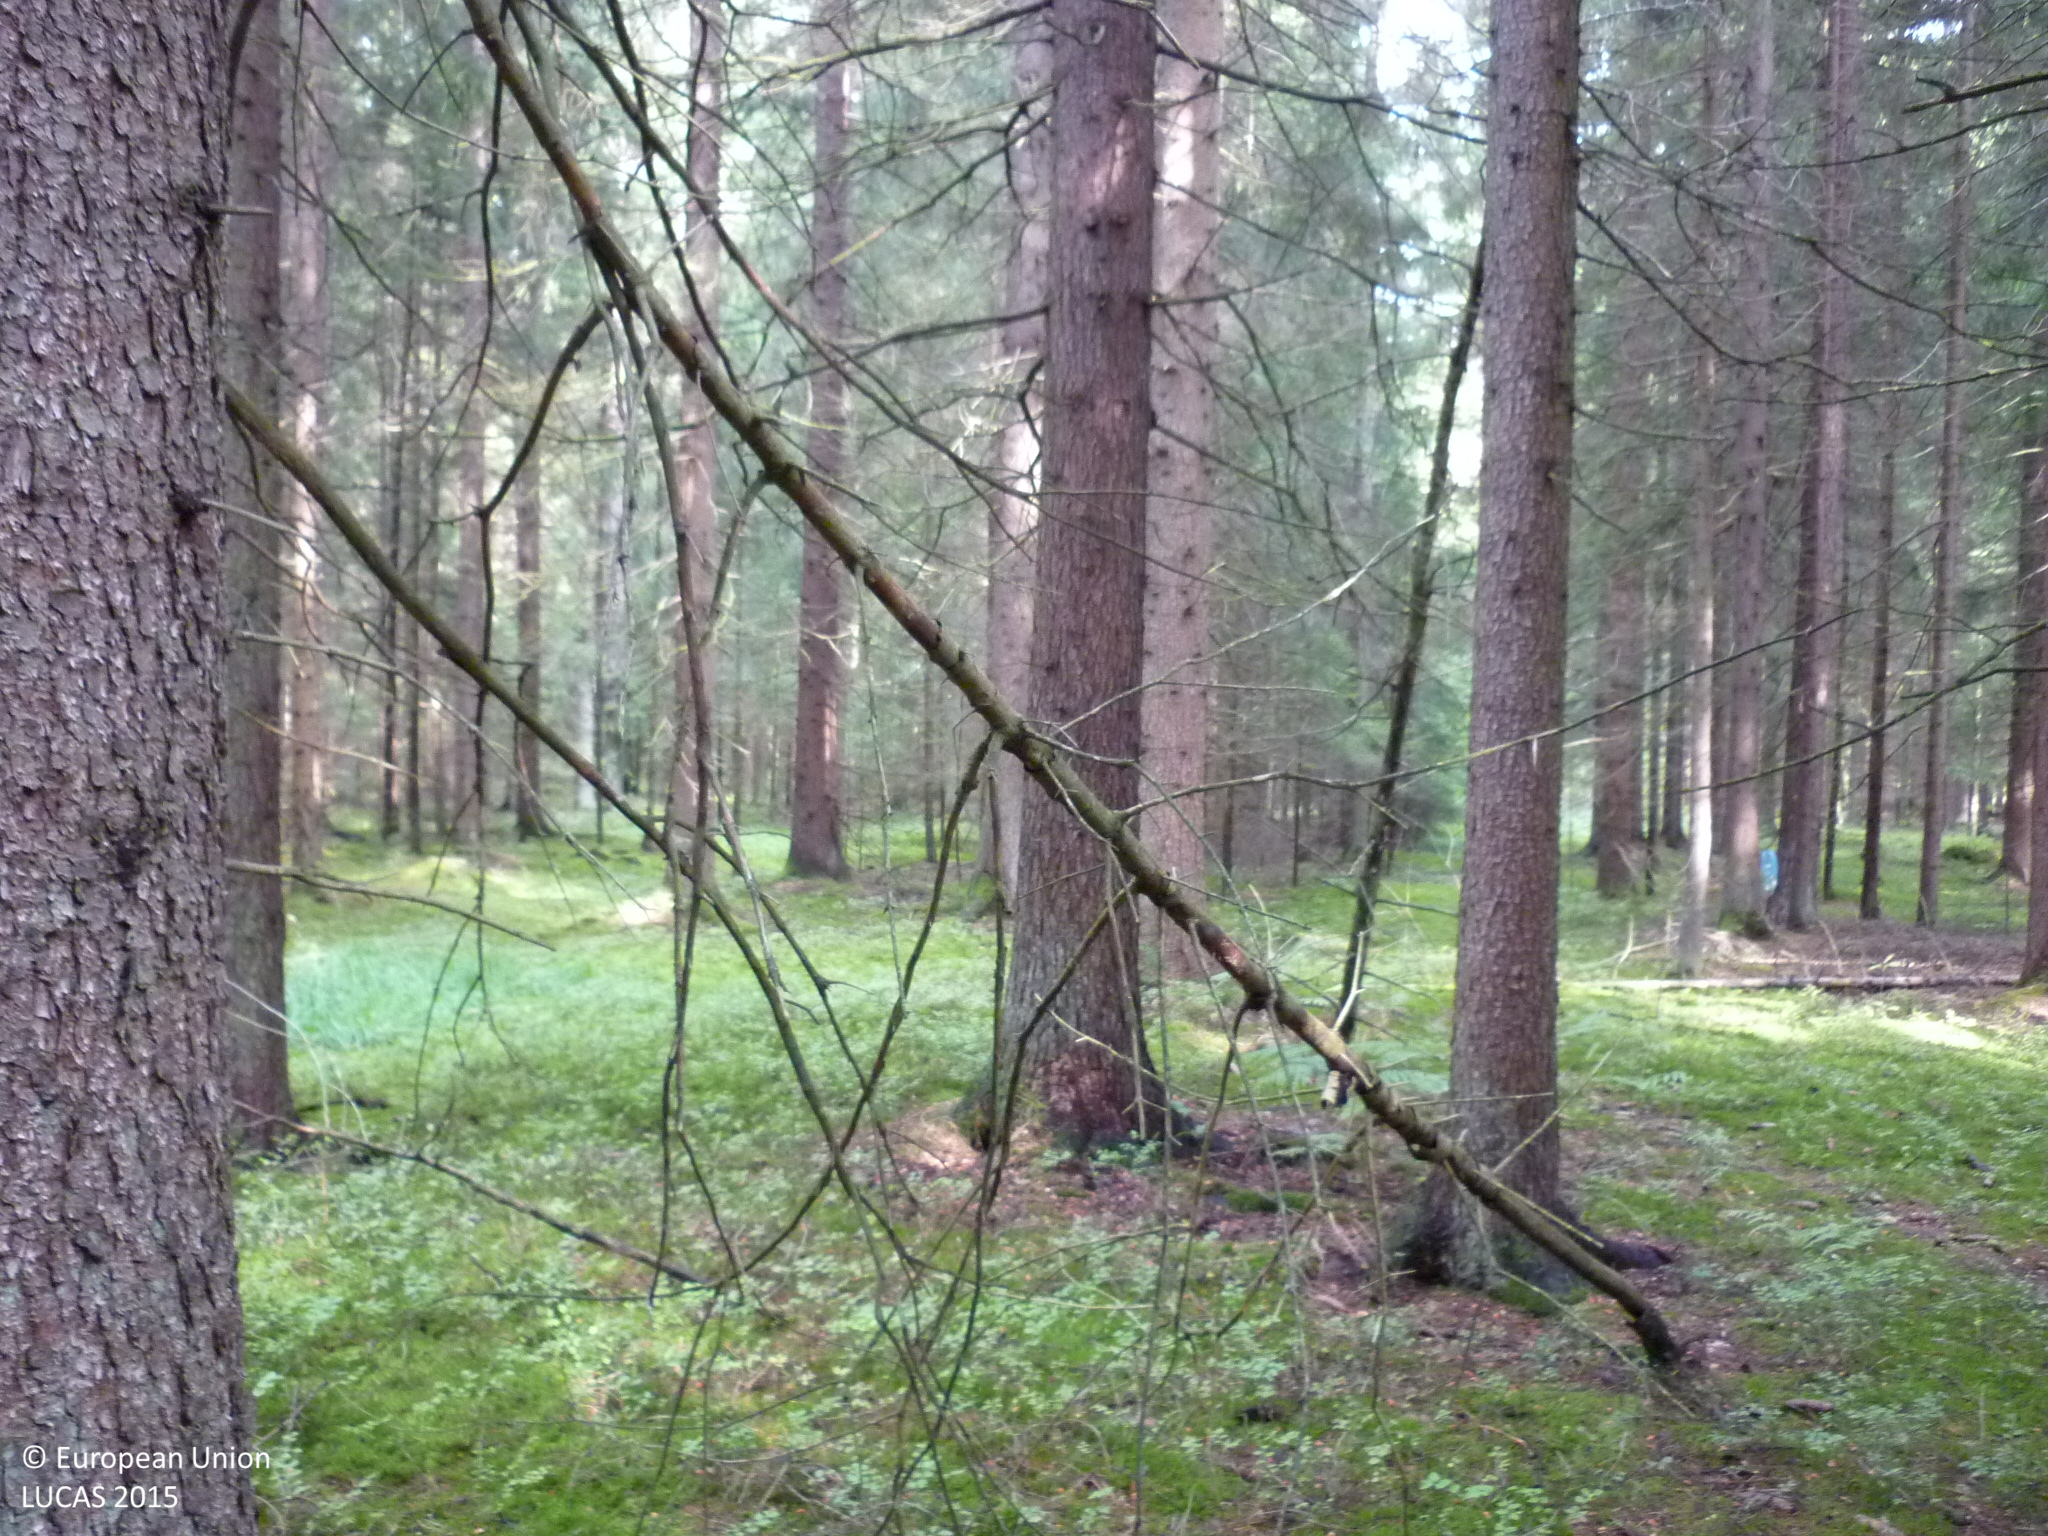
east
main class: Woodland
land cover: Spruce dominated coniferous woodland
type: hemiboreal forest and nemoral coniferous forest and mixed broadleaved-coniferous forest
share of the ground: > 75 %
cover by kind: coniferous forest trees 100 %
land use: Forestry
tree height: > 5 m
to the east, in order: Spruce dominated coniferous woodland; Tracks; Spruce dominated coniferous woodland; Rivers and streams; Spruce dominated coniferous woodland; Tracks
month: September
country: AT
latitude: 48.9159
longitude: 15.1195
